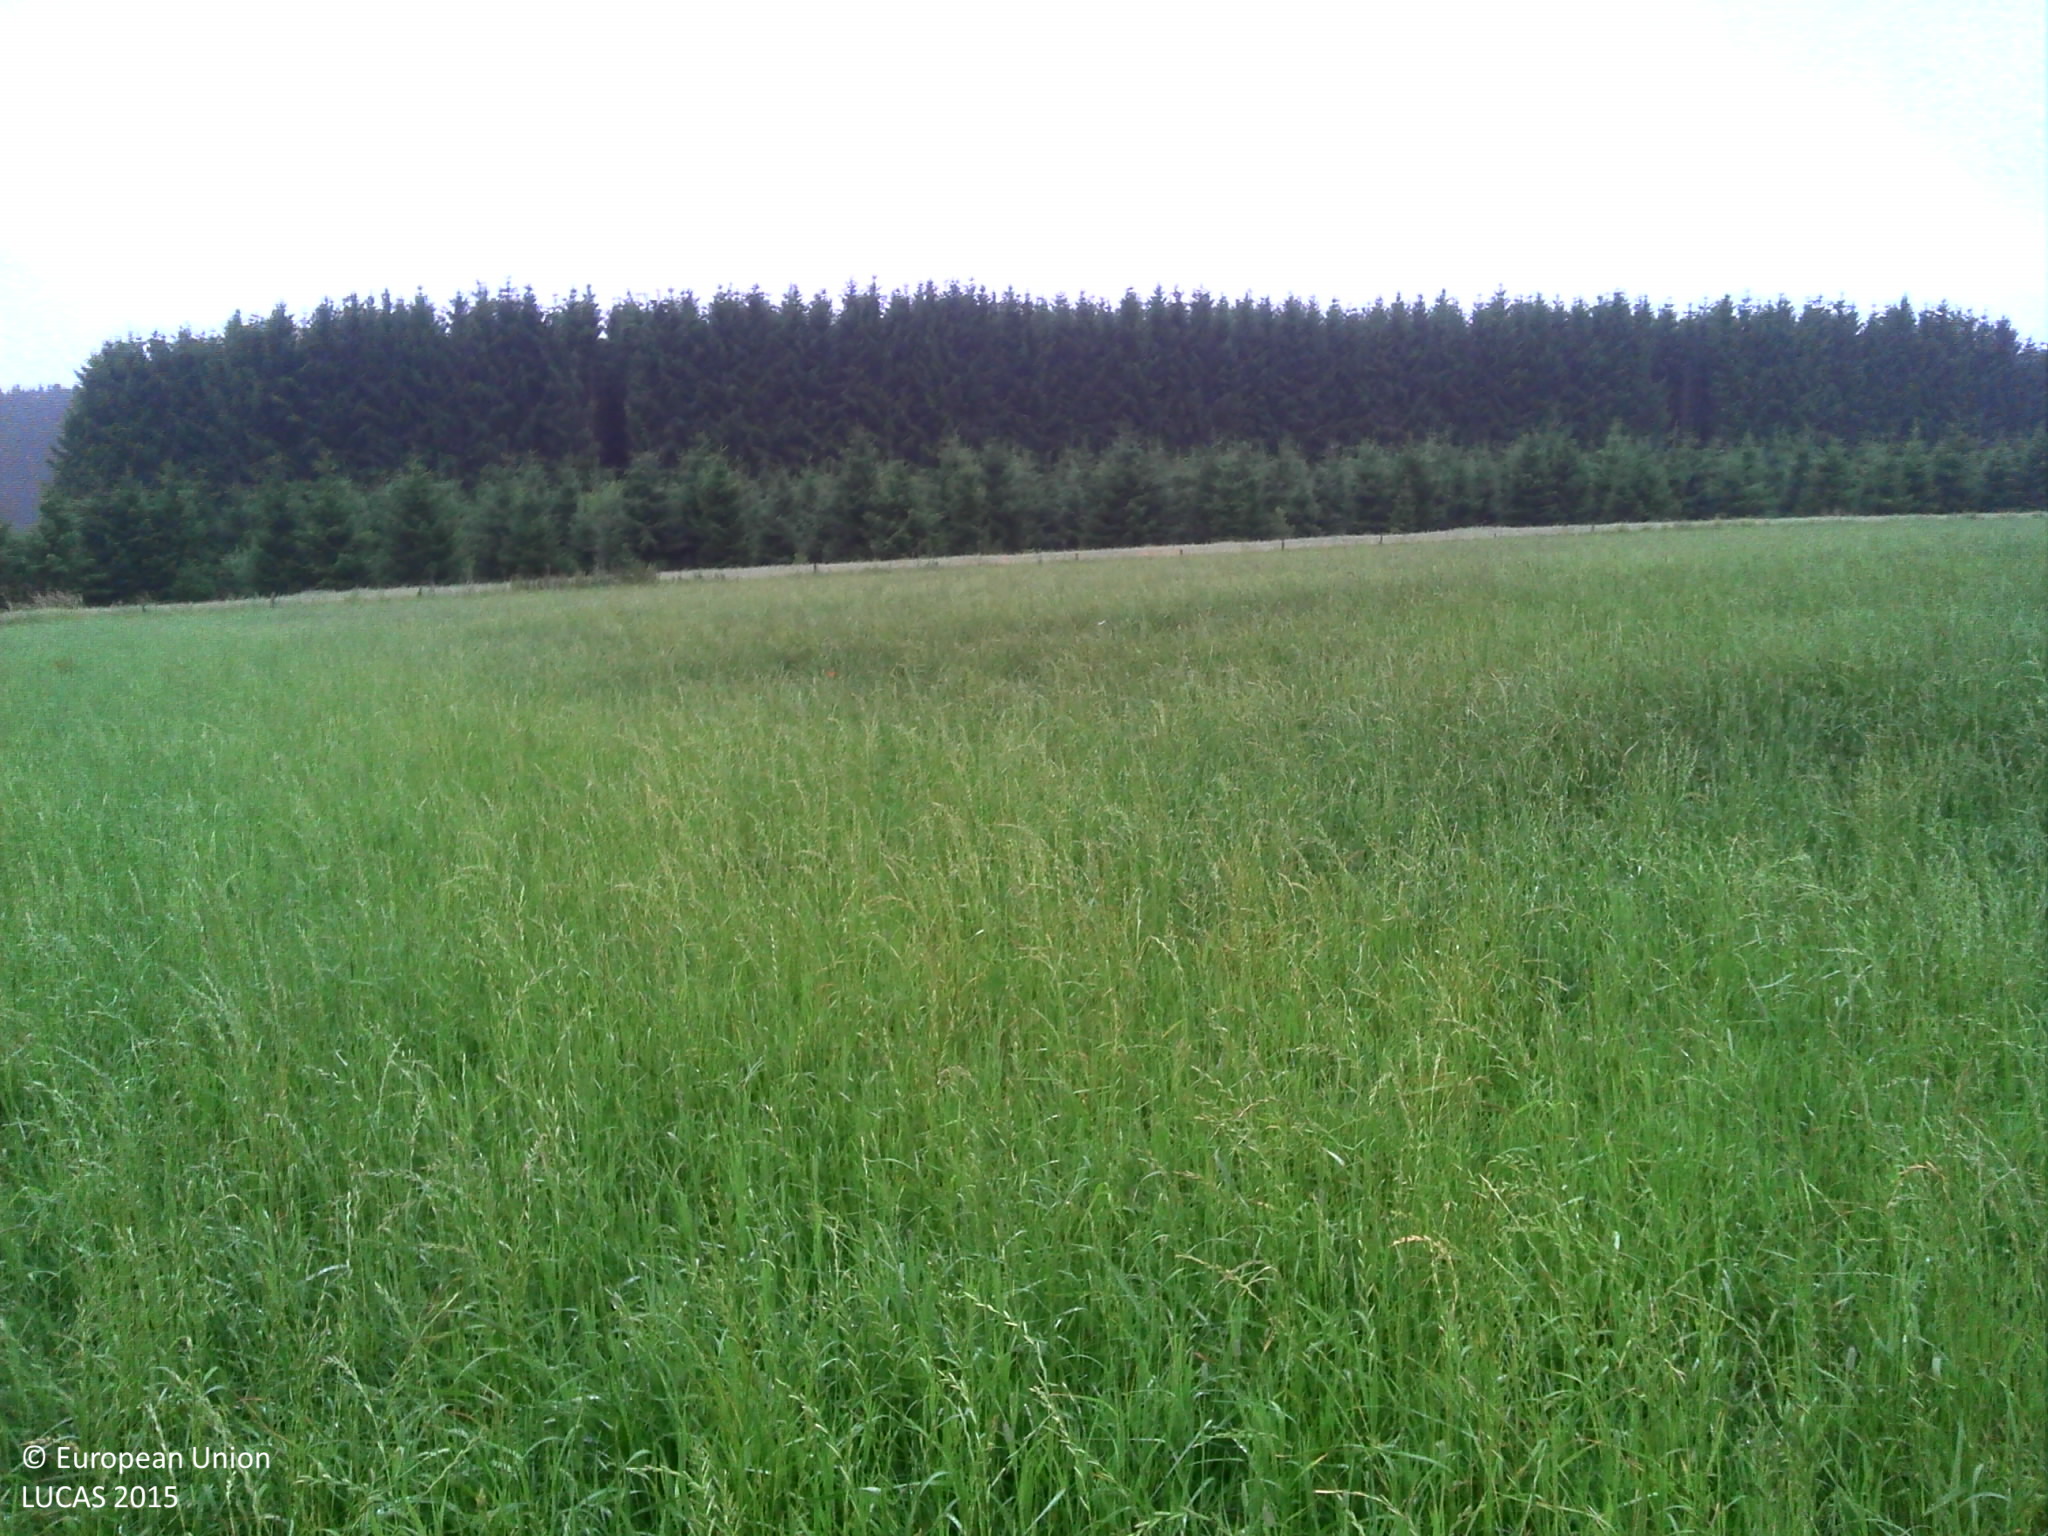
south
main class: Grassland
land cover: Grassland without tree/shrub cover
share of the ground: > 75 %
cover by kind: herbaceous plants 100 %
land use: Agriculture (excluding fallow land and kitchen gardens)
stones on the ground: < 10 %
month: July
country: BE
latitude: 50.0865
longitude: 5.7359
